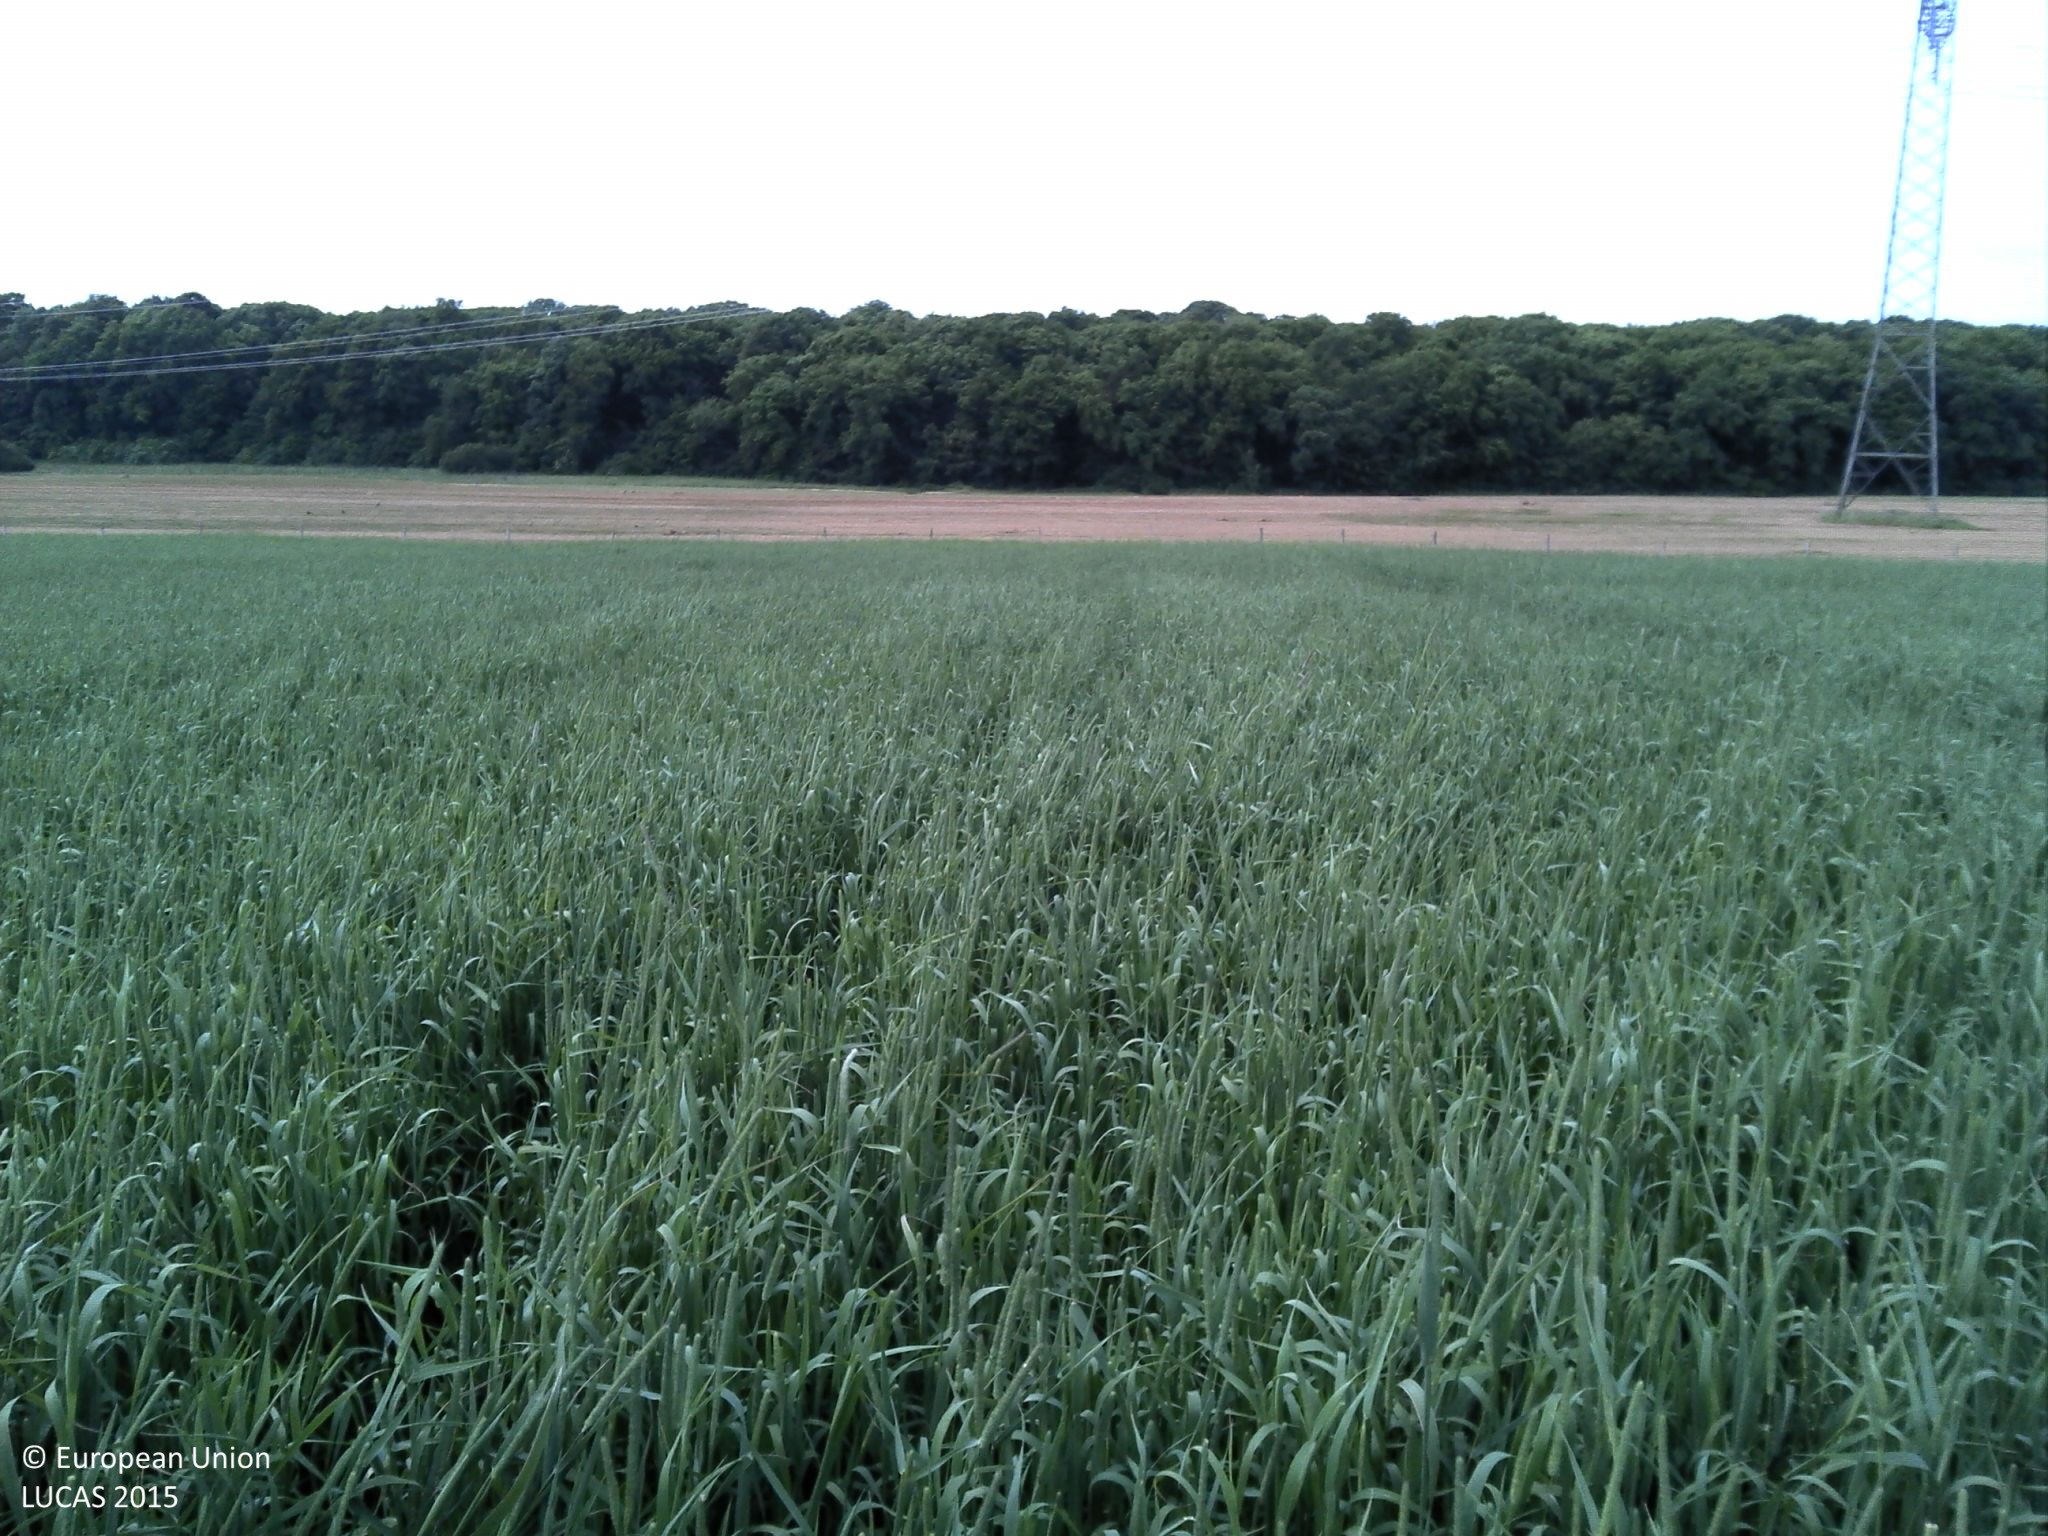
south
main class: Cropland
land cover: Temporary grasslands
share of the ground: > 75 %
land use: Agriculture (excluding fallow land and kitchen gardens)
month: June
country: LU
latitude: 49.5551
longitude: 5.9766
